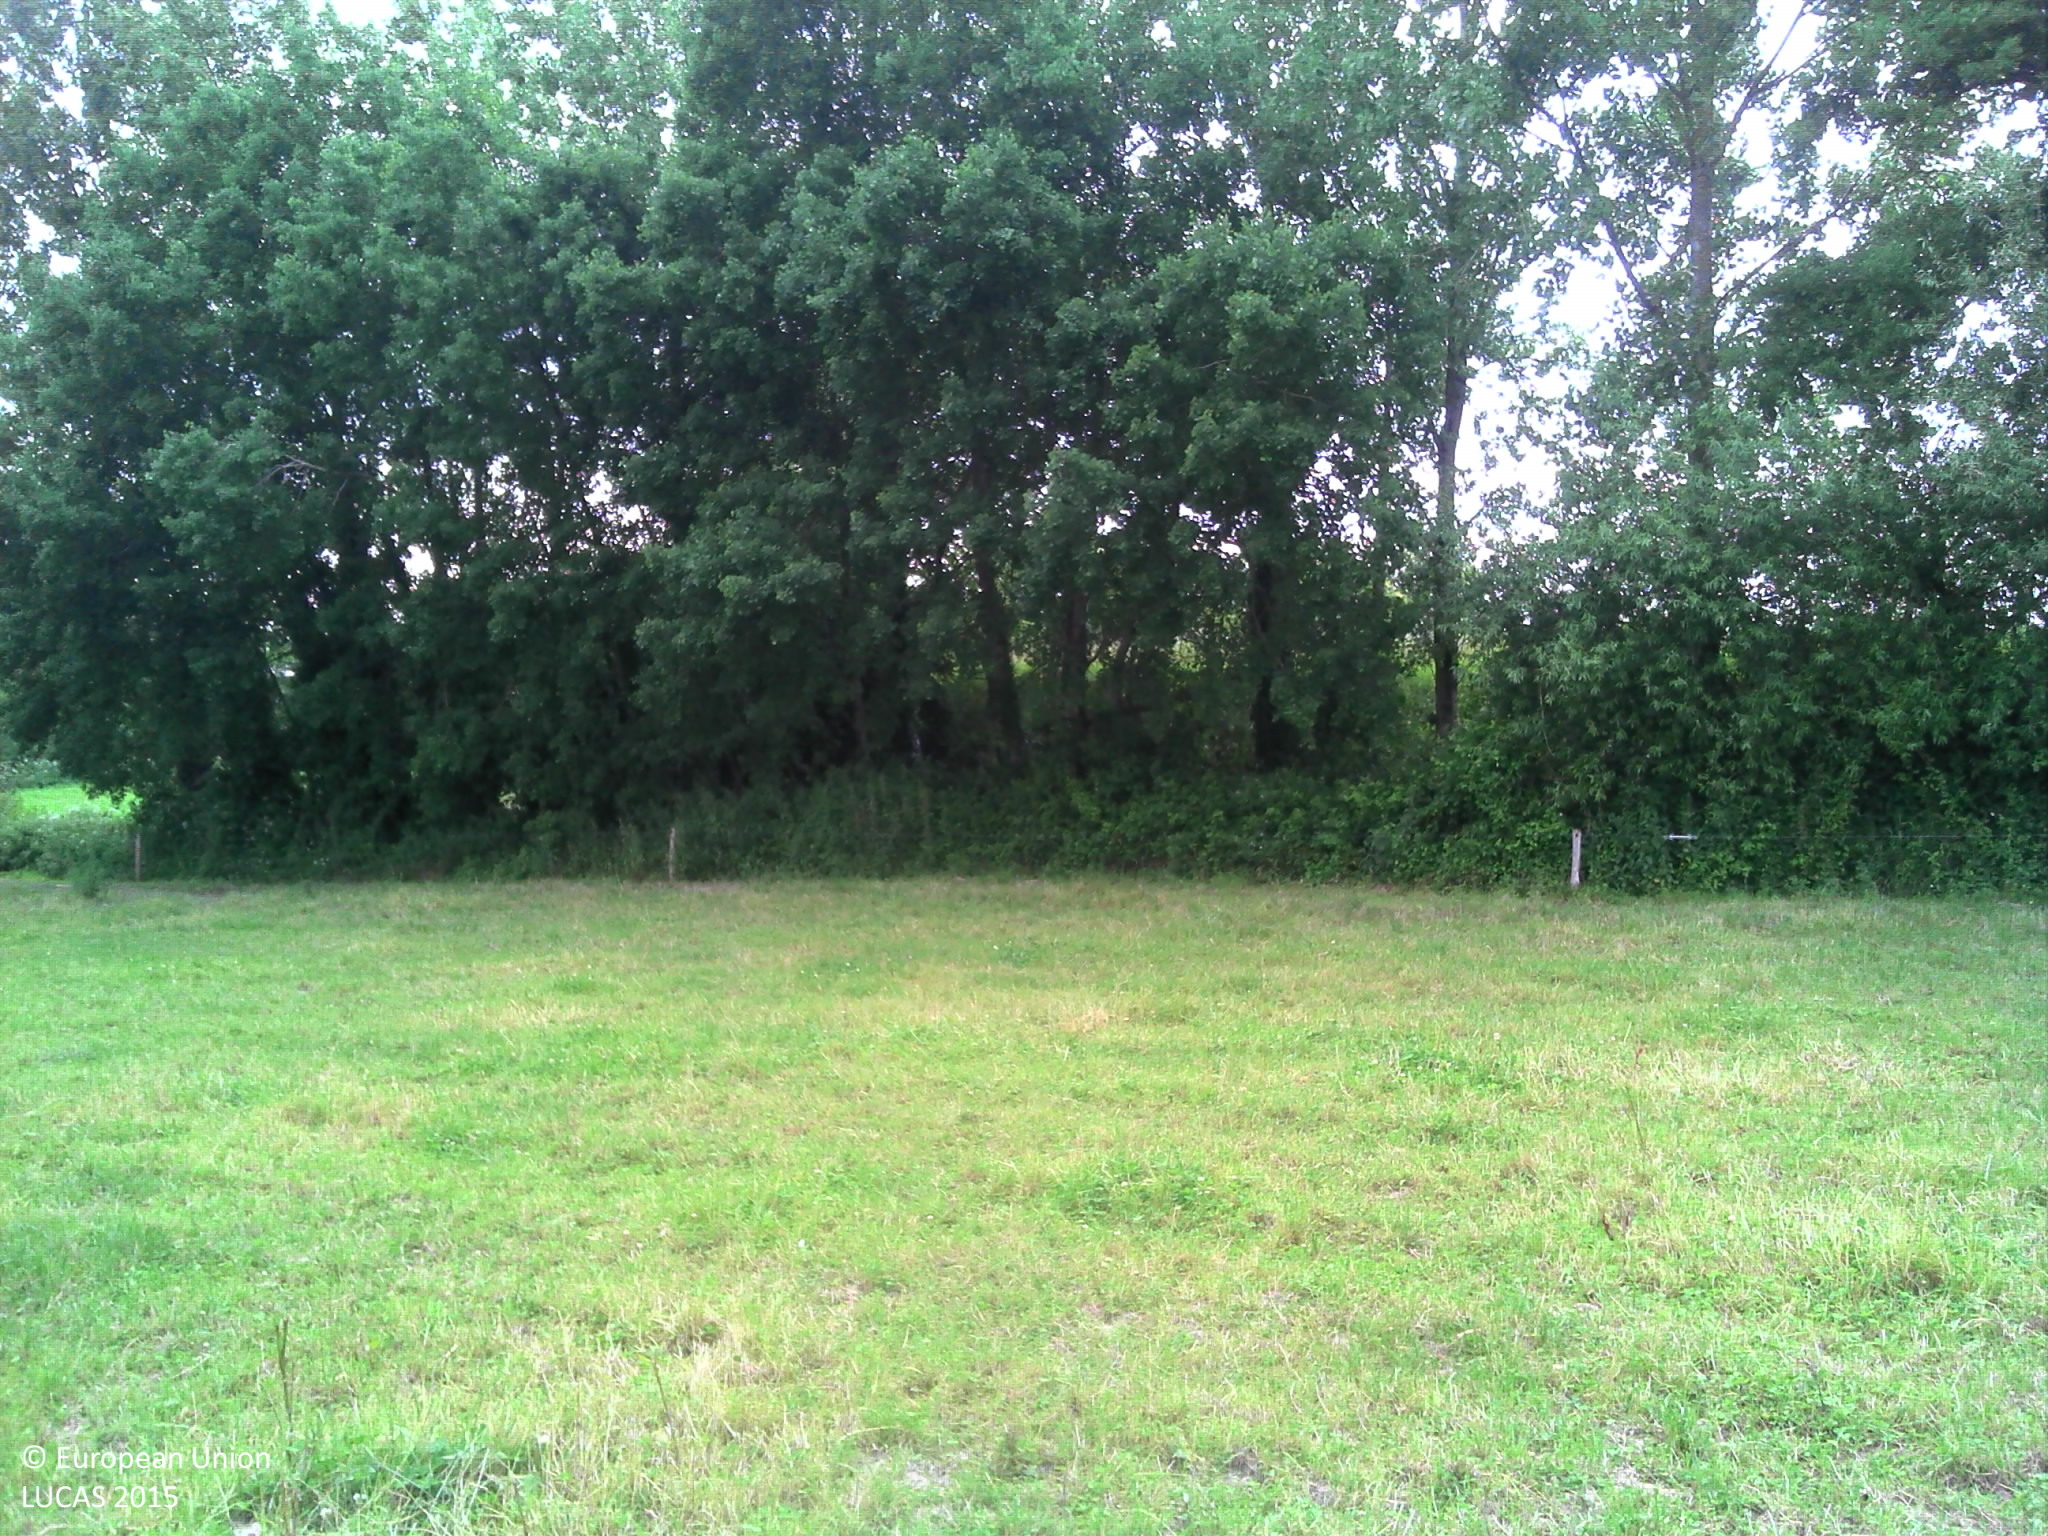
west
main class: Grassland
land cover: Grassland without tree/shrub cover
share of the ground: > 75 %
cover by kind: herbaceous plants 100 %
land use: Agriculture (excluding fallow land and kitchen gardens)
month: June
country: FR
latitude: 46.7814
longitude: -1.6857
